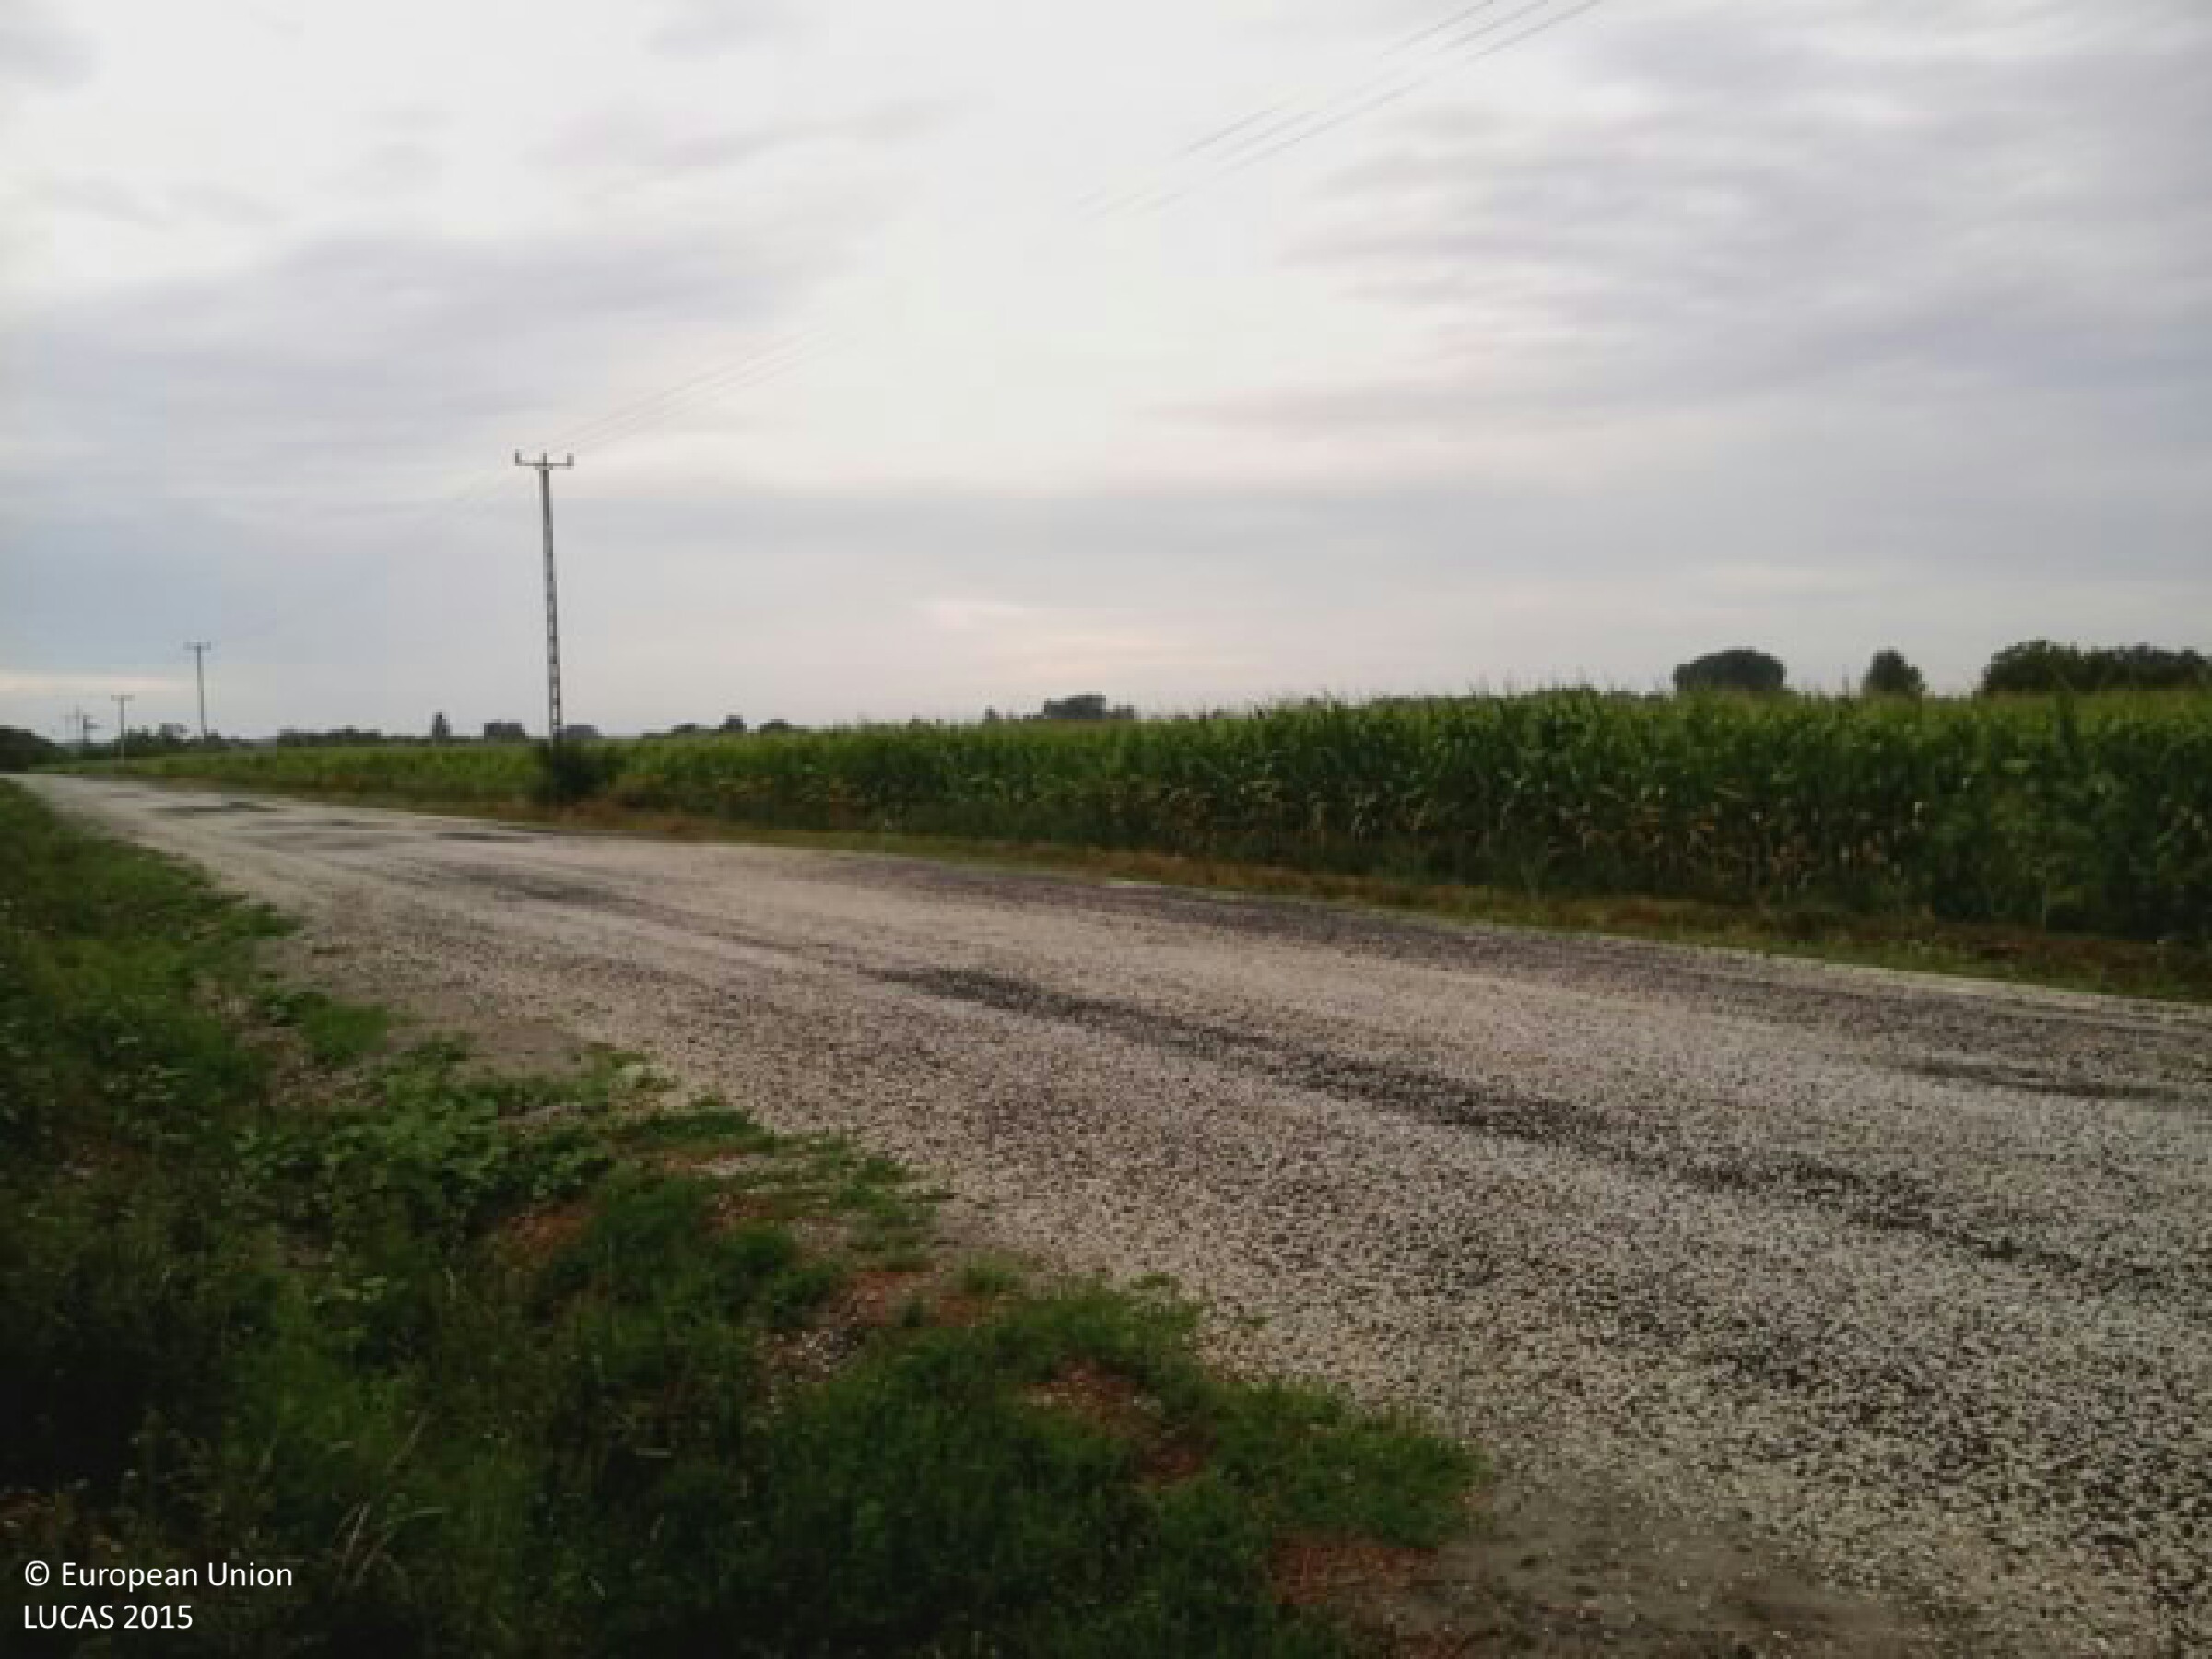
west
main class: Cropland
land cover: Sunflower
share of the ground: > 75 %
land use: Agriculture (excluding fallow land and kitchen gardens)
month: July
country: HU
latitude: 46.3831
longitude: 18.8407
